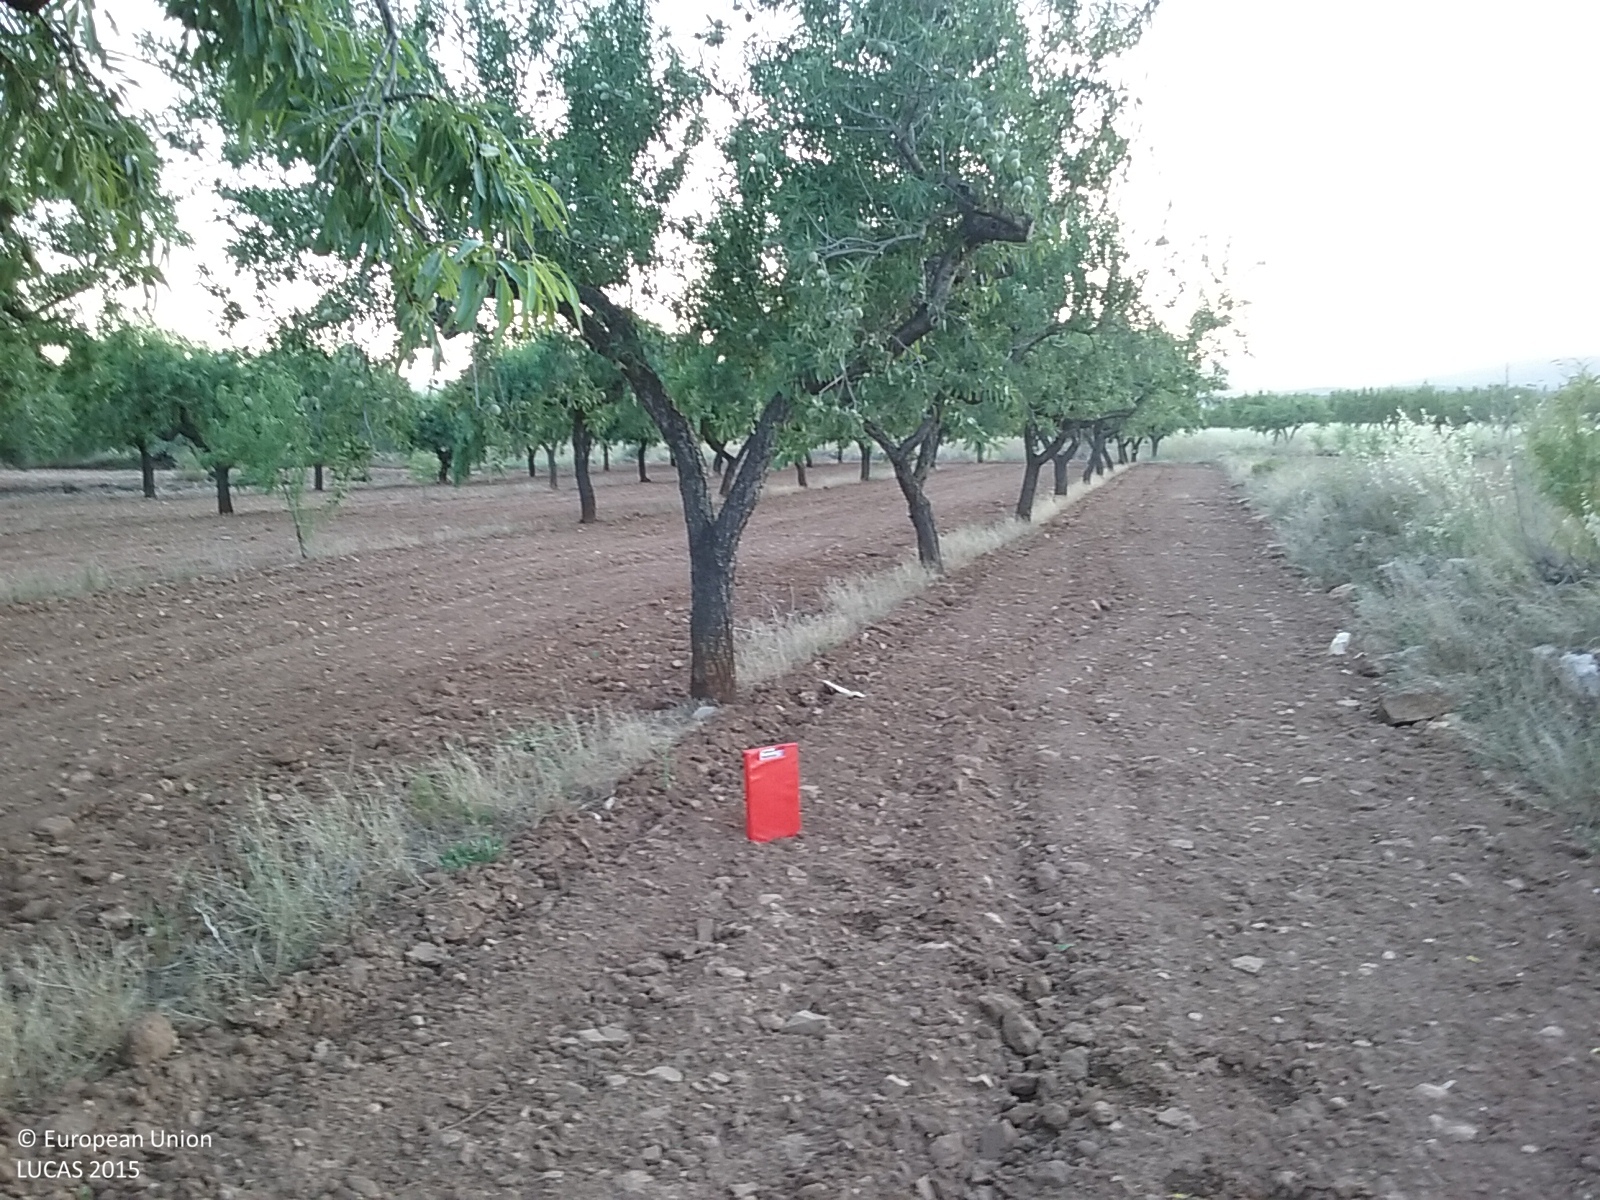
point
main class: Cropland
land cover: Nuts trees
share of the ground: 50 - 75 %
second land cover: Other bare soil
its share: > 75 %
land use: Agriculture (excluding fallow land and kitchen gardens)
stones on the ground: < 10 %
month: May
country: ES
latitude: 40.1853
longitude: -0.0686
